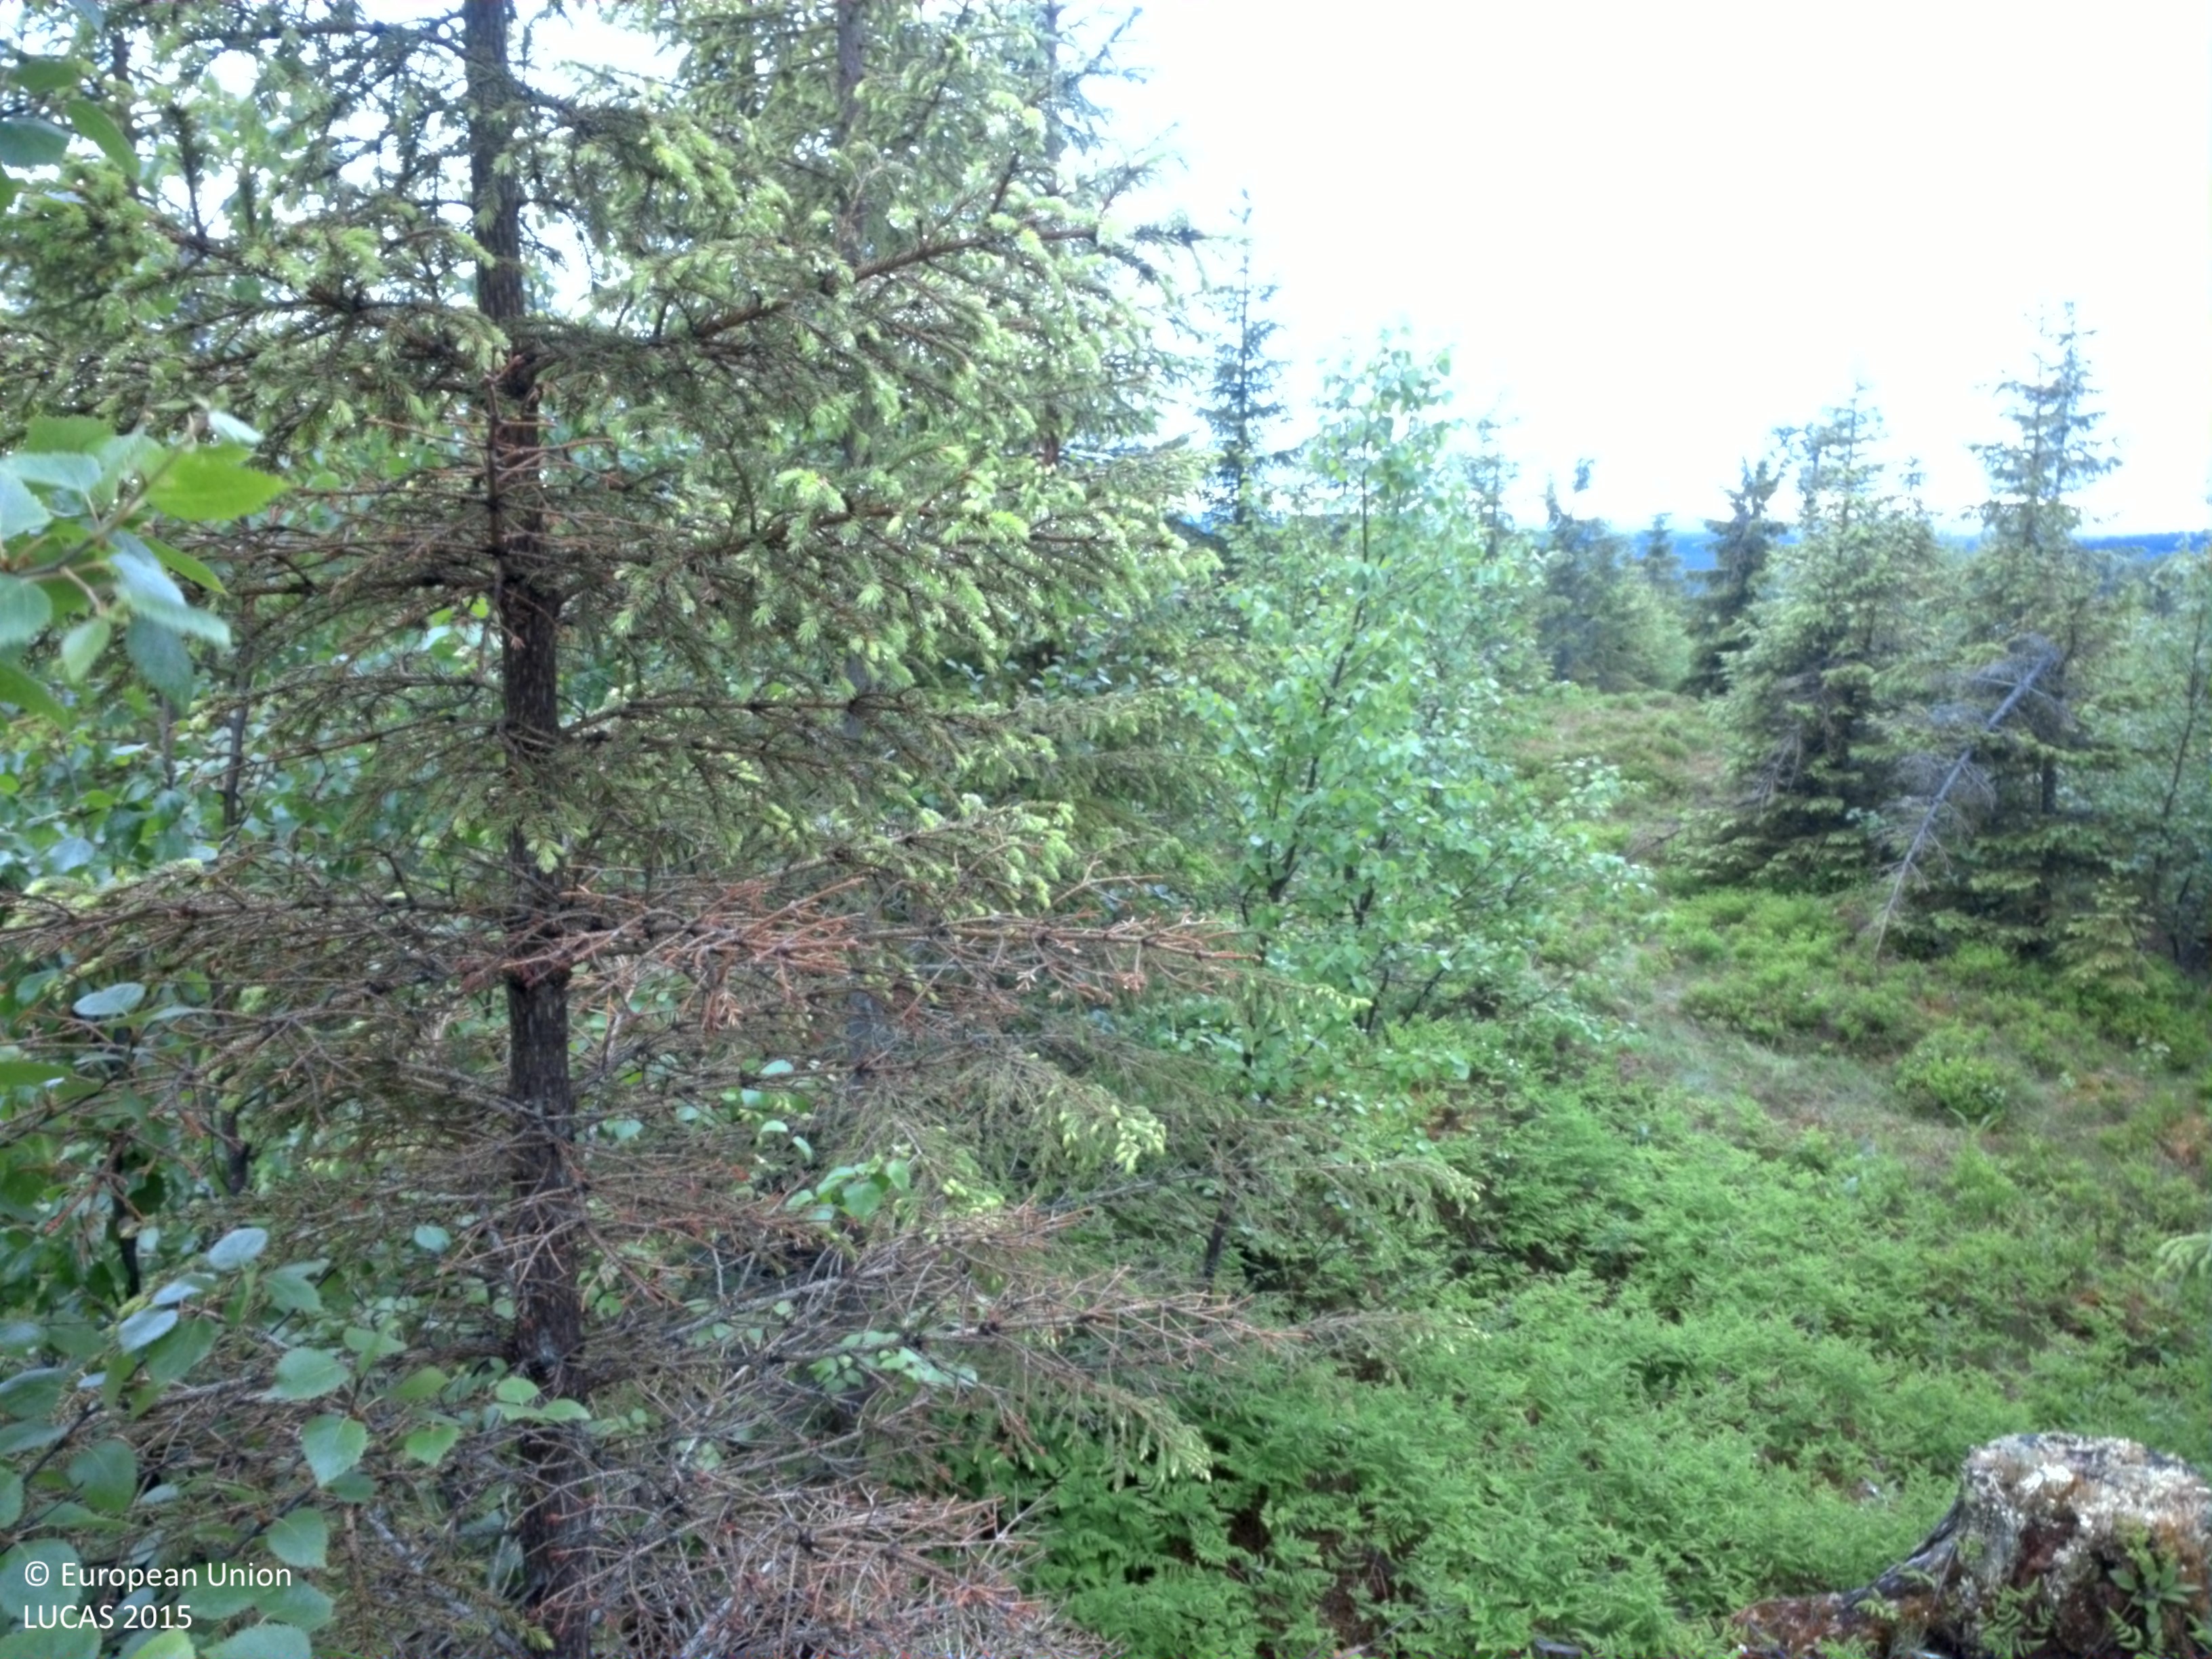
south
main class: Woodland
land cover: Spruce dominated mixed woodland
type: boreal forest
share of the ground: 50 - 75 %
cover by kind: coniferous forest trees 45 %, shrubs 25 %, broadleaved forest trees 15 %, herbaceous plants 15 %
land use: Forestry
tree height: > 5 m
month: July
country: SE
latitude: 64.3922
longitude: 18.0765
